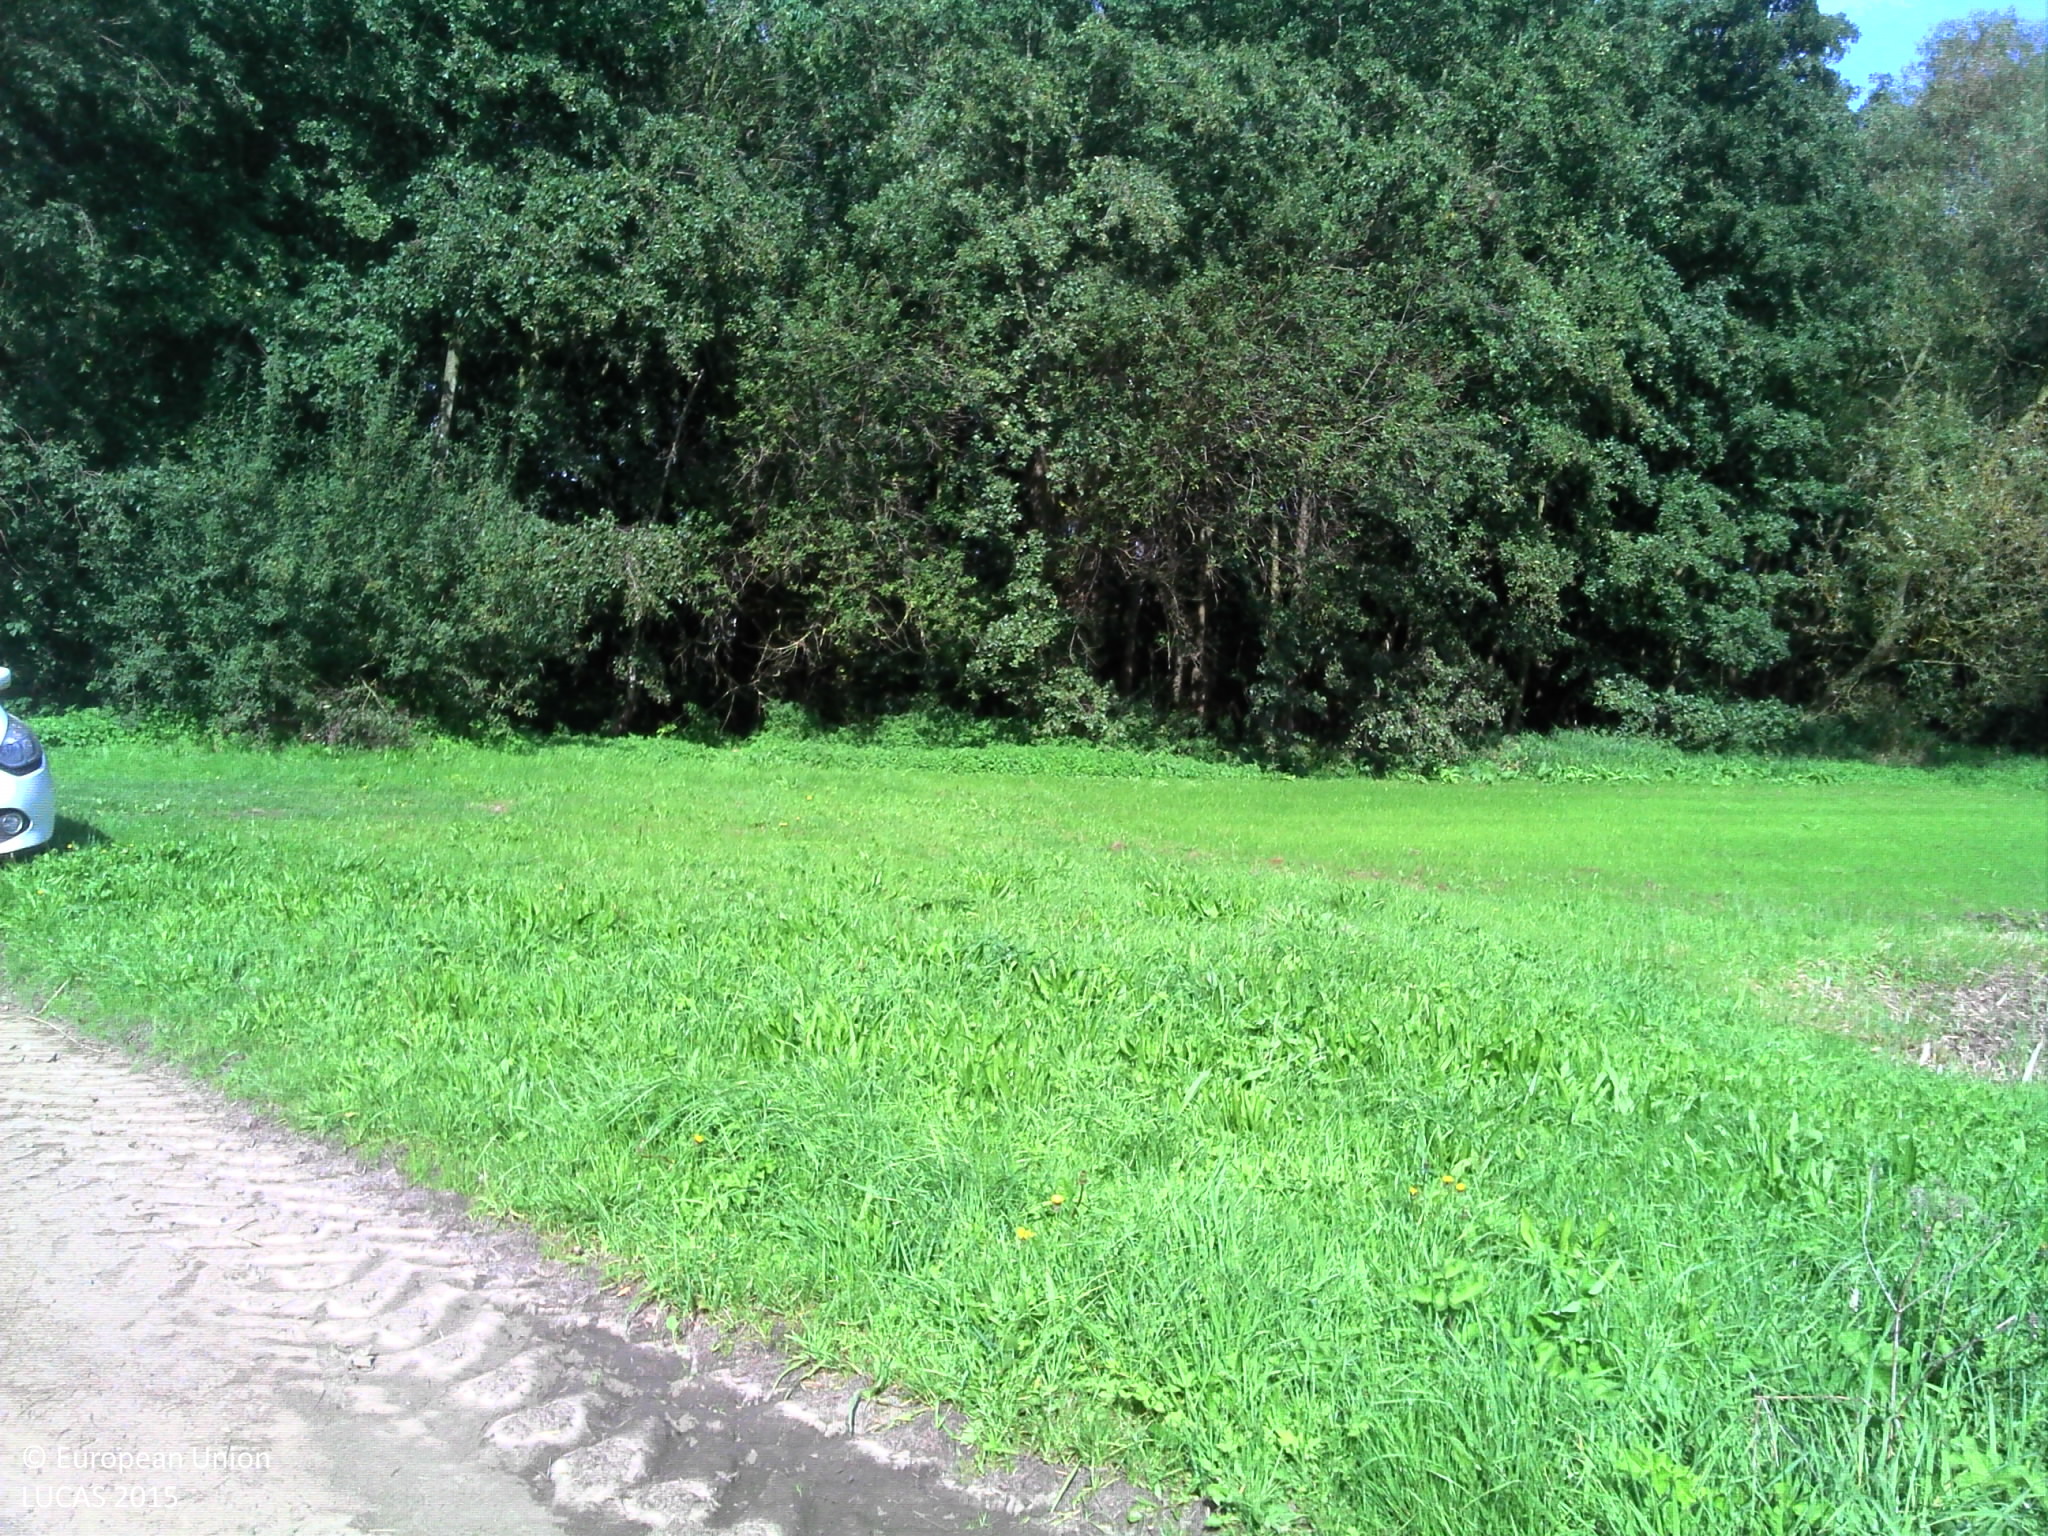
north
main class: Grassland
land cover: Grassland without tree/shrub cover
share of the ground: > 75 %
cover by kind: herbaceous plants 100 %
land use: Agriculture (excluding fallow land and kitchen gardens)
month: September
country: BE
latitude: 51.1227
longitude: 4.6670
